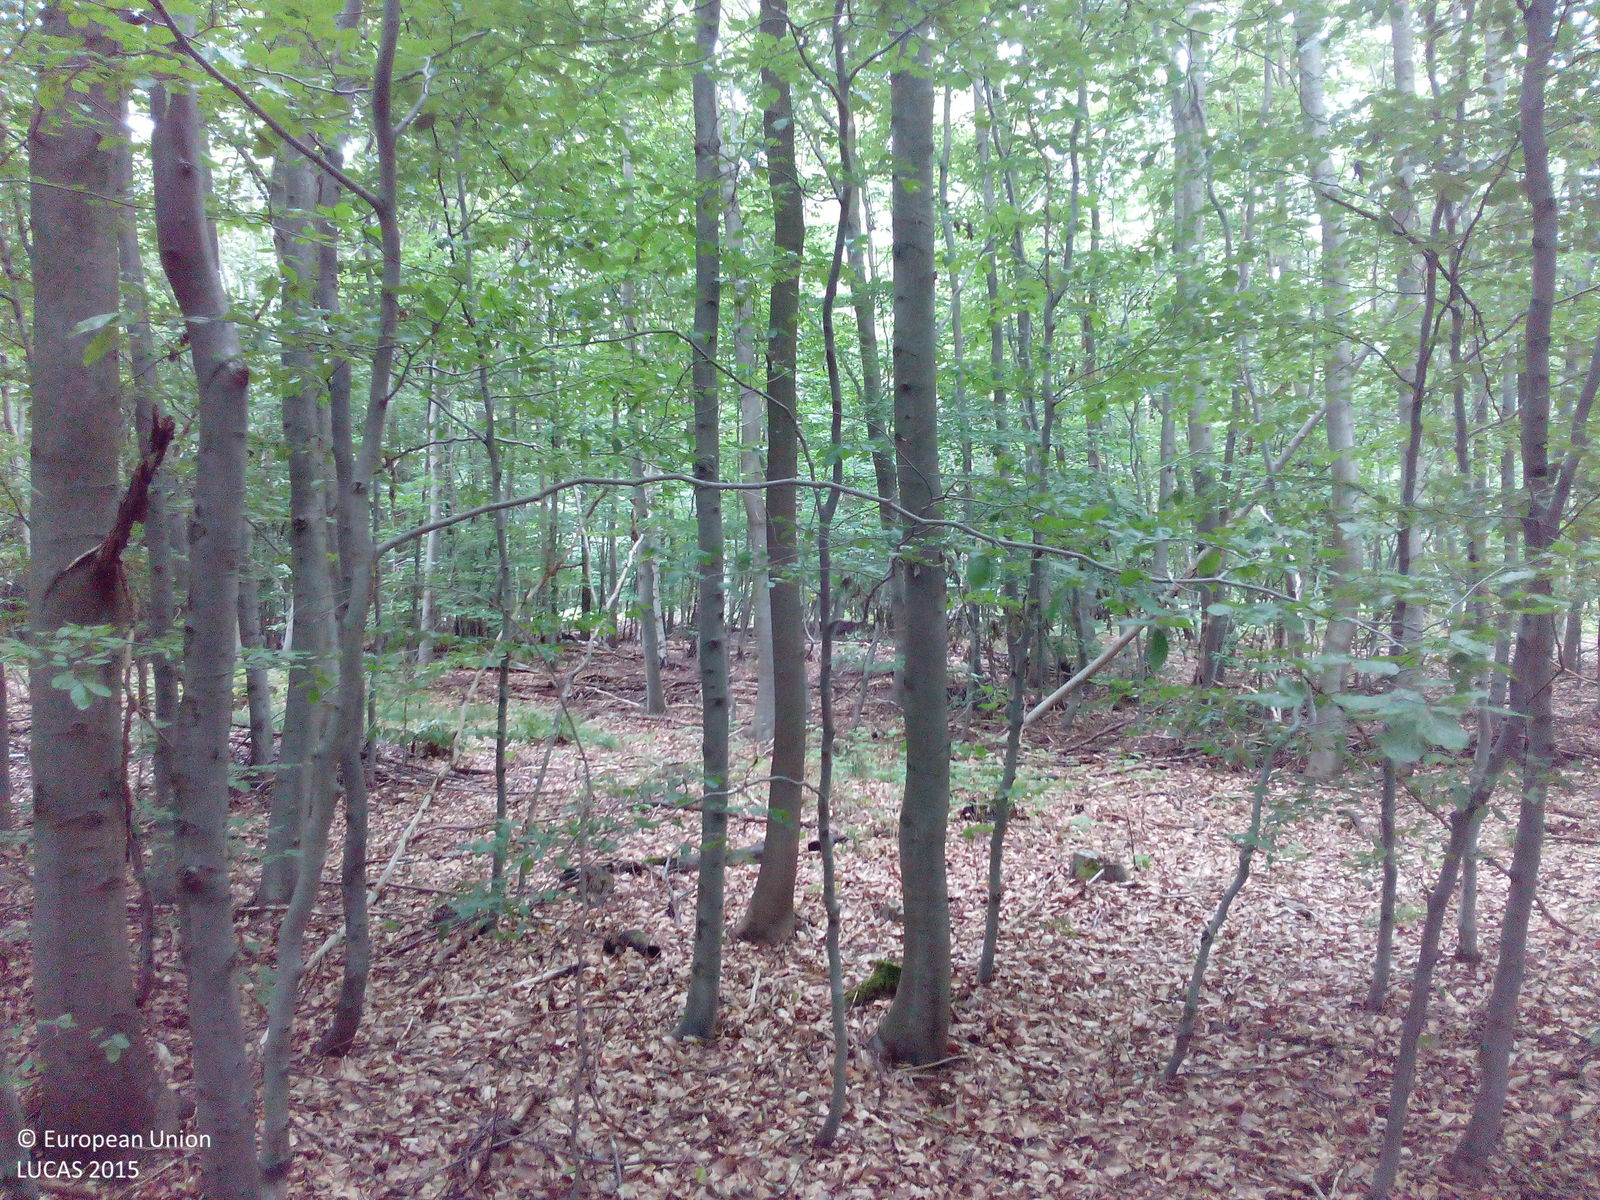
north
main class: Woodland
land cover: Broadleaved woodland
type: beech forest
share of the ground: > 75 %
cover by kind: broadleaved forest trees 100 %
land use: Forestry
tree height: > 5 m
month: August
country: DE
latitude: 51.6891
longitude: 11.1135
